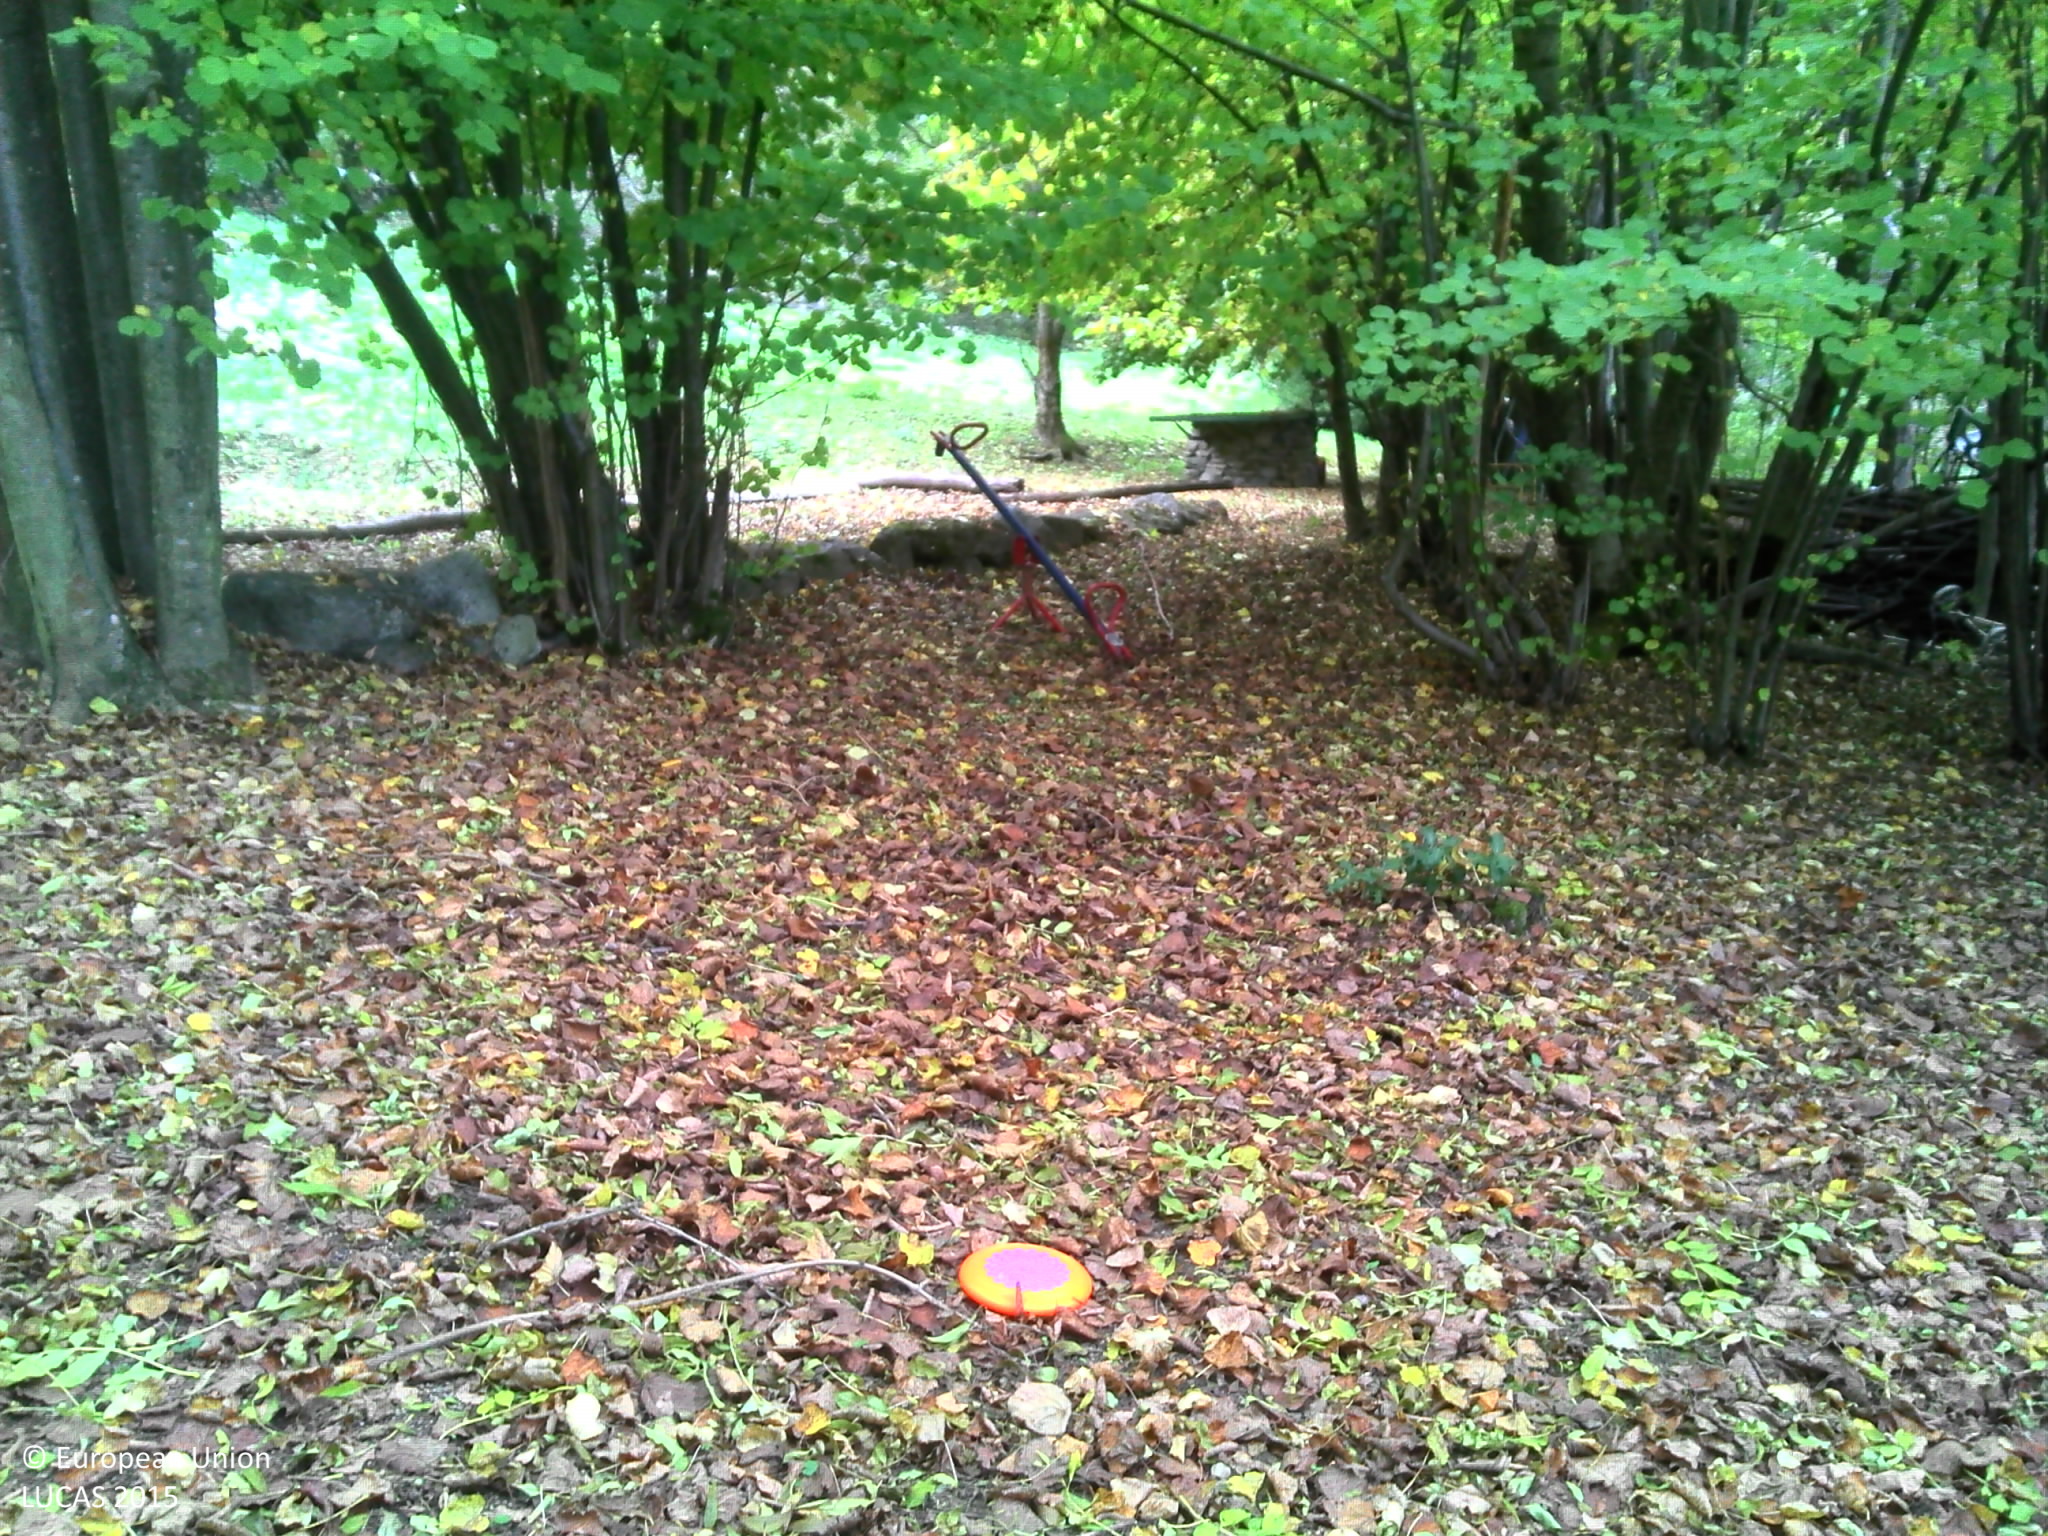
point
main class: Woodland
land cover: Broadleaved woodland
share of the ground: > 75 %
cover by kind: broadleaved forest trees 90 %, unconsolidated bare surface 10 %
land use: Residential
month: October
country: FR
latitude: 45.3842
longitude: 6.2628
